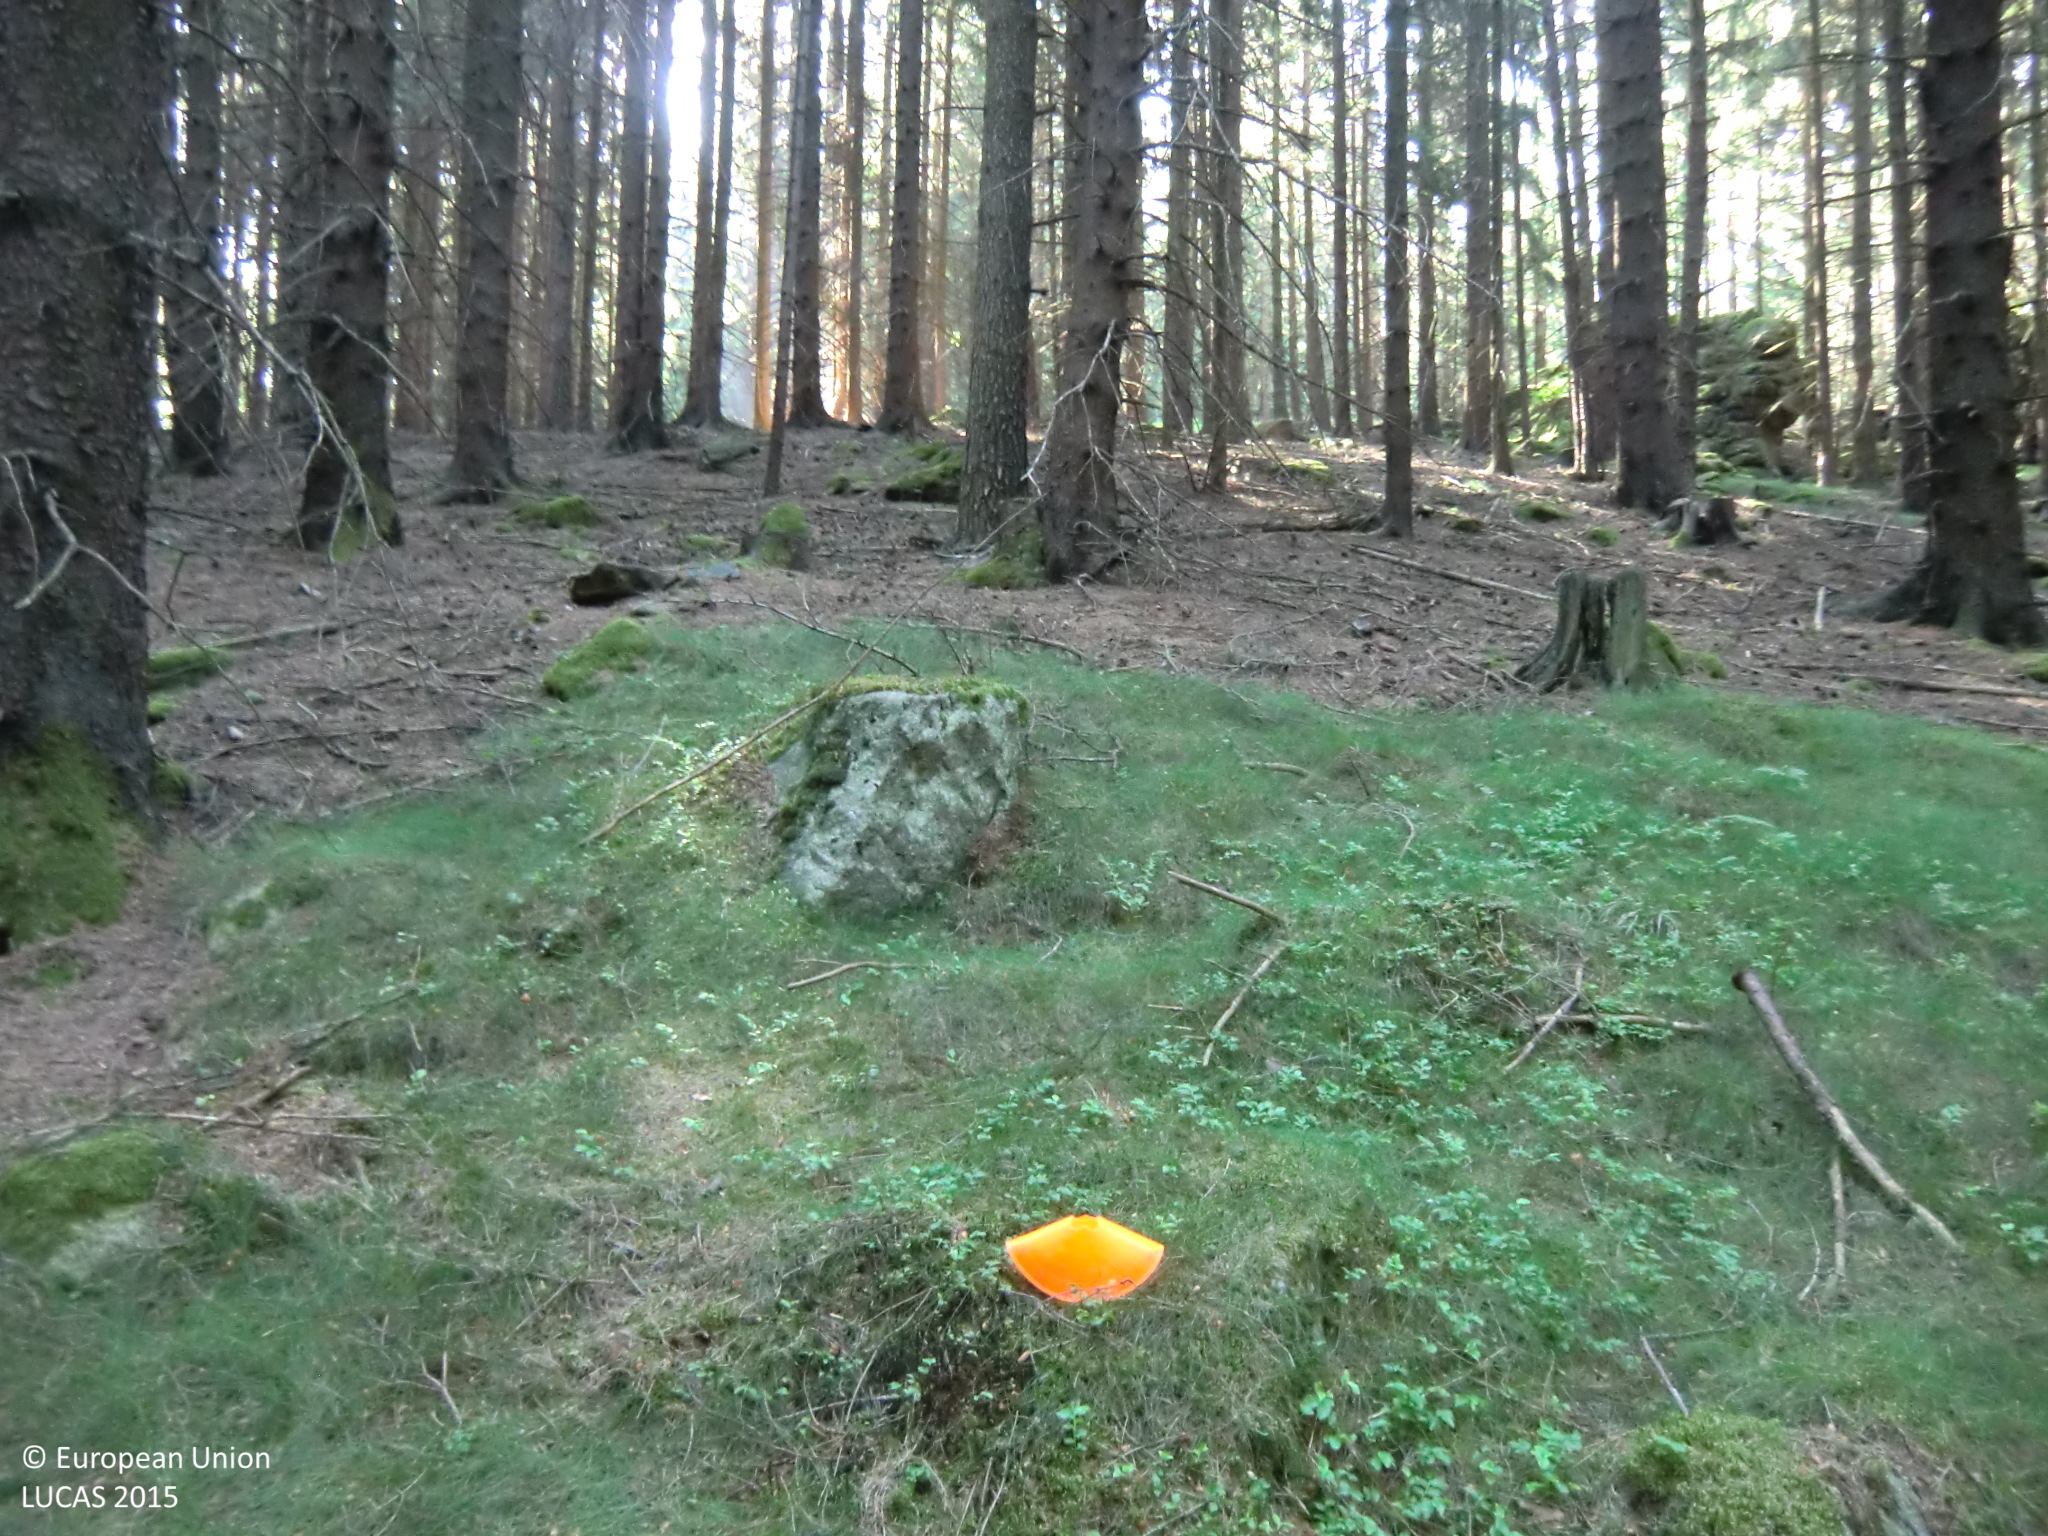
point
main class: Woodland
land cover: Spruce dominated coniferous woodland
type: hemiboreal forest and nemoral coniferous forest and mixed broadleaved-coniferous forest
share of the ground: > 75 %
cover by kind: coniferous forest trees 80 %, herbaceous plants 10 %, lichens and mosses 5 %, unconsolidated bare surface 5 %
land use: Forestry
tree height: > 5 m
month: June
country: AT
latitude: 48.4603
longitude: 14.3955
